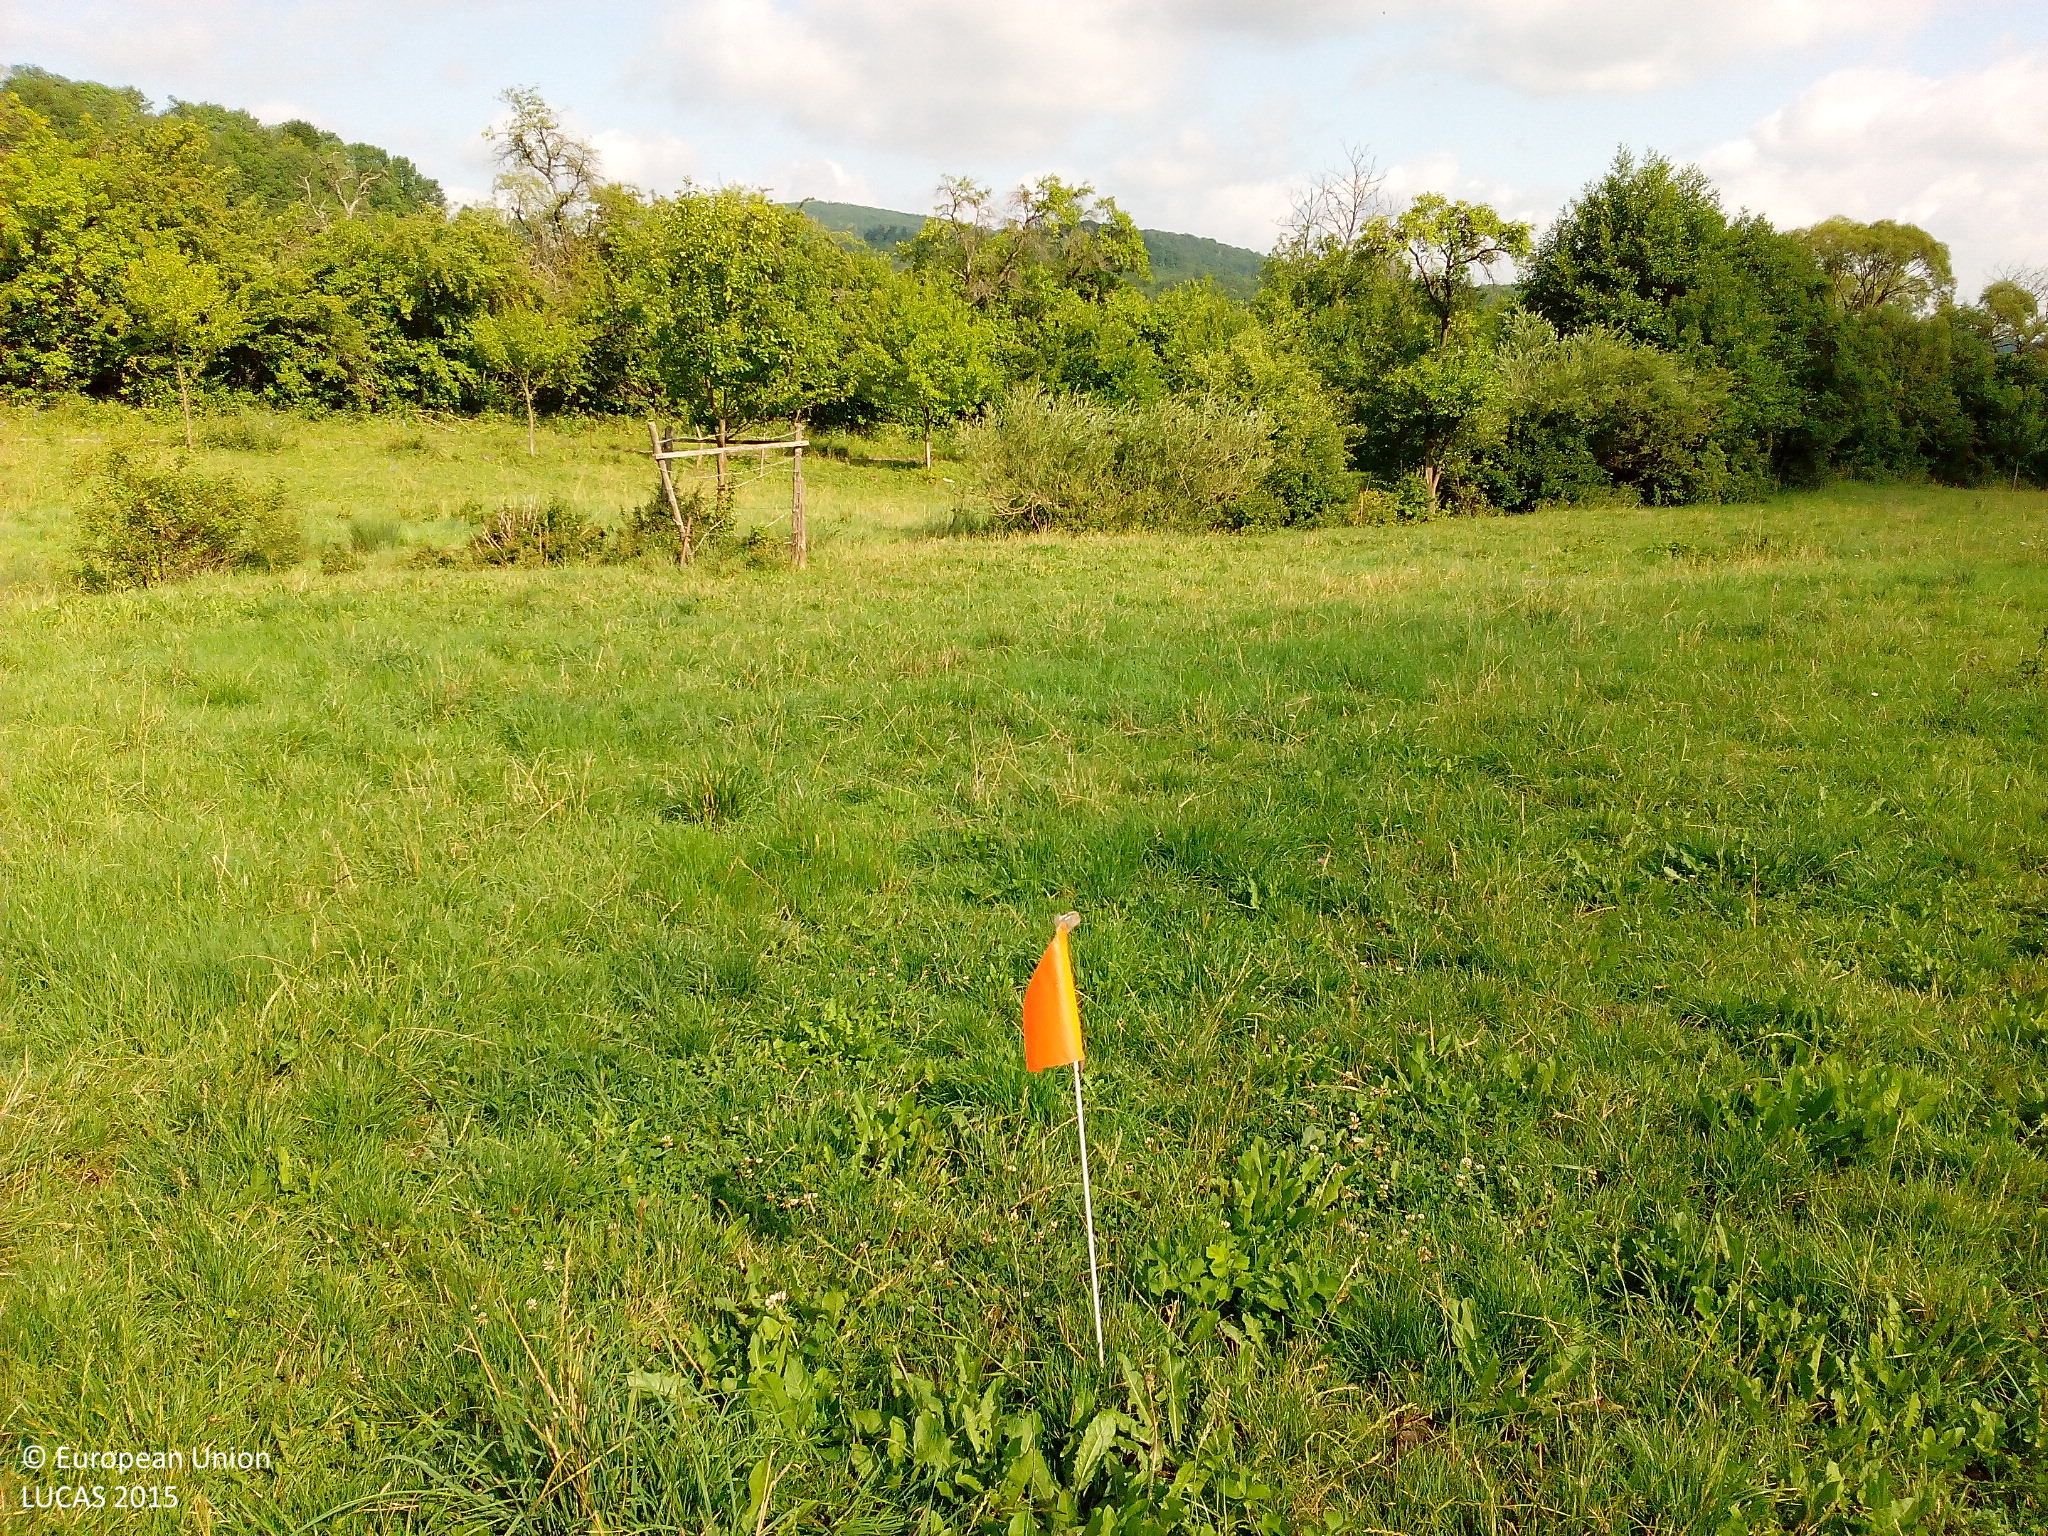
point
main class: Grassland
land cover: Grassland without tree/shrub cover
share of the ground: > 75 %
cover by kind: herbaceous plants 100 %
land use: Agriculture (excluding fallow land and kitchen gardens)
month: July
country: DE
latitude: 50.6517
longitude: 9.9010
